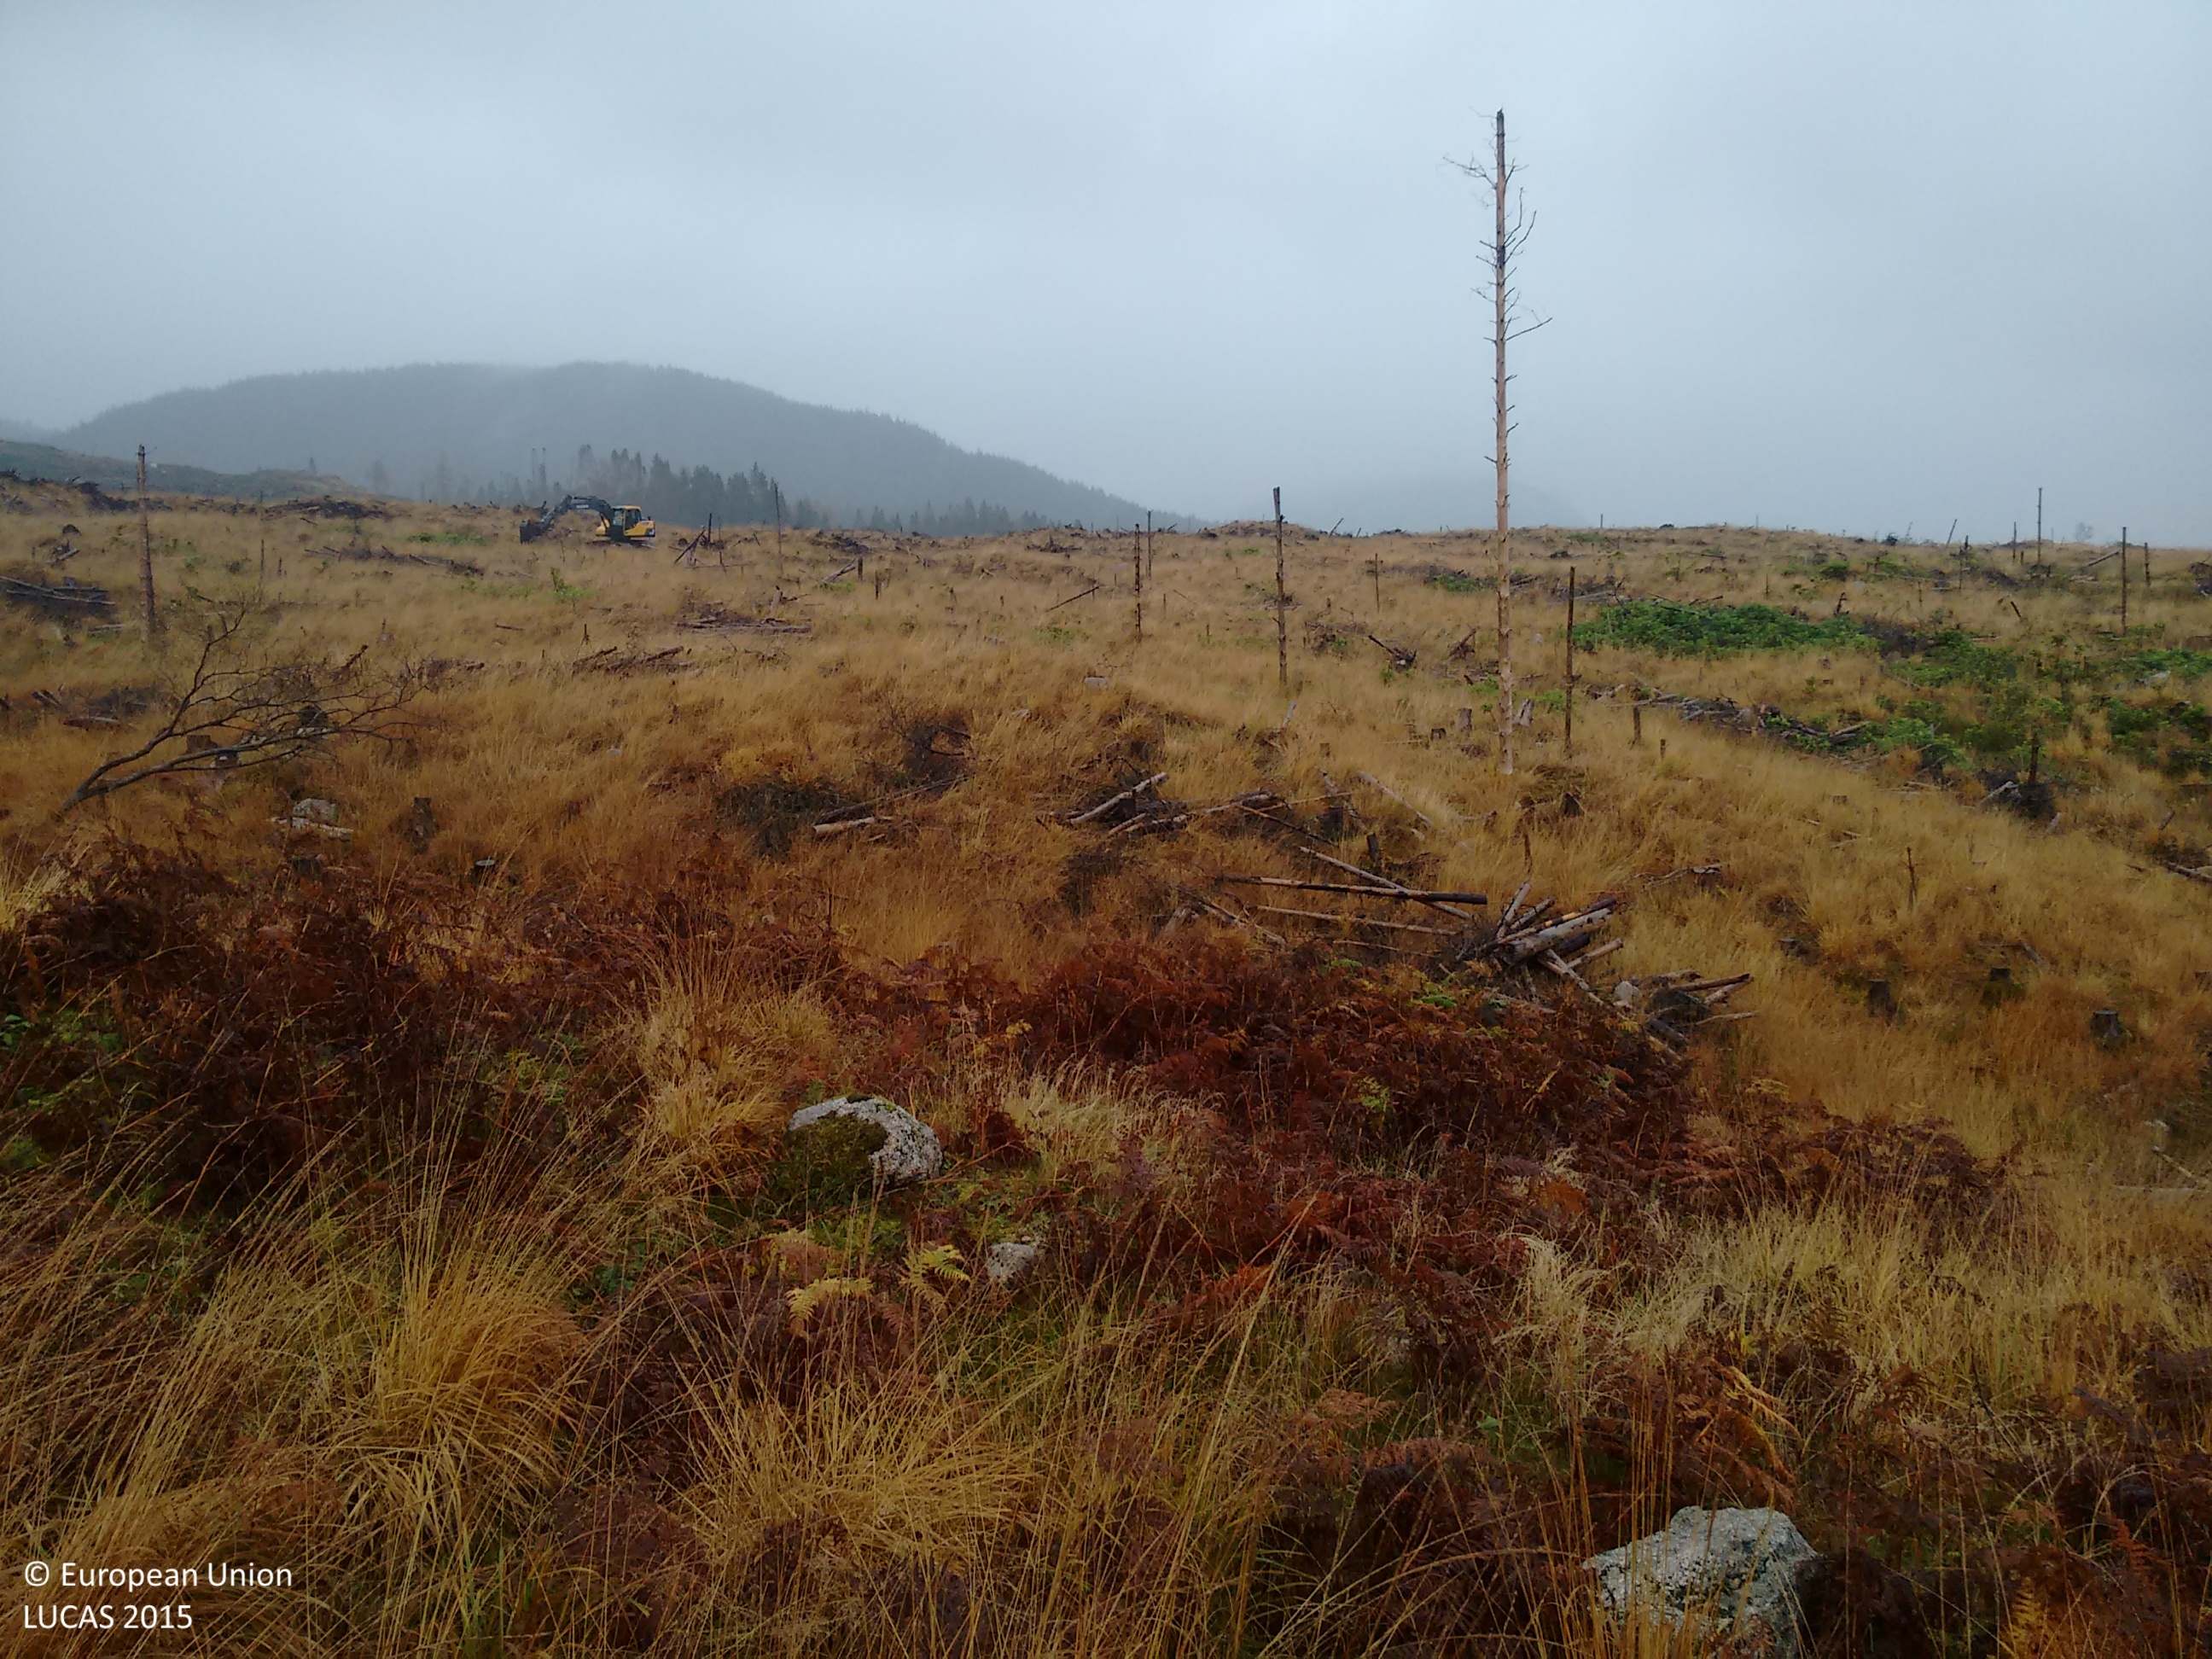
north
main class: Grassland
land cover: Grassland with sparse tree/shrub cover
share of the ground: > 75 %
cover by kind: herbaceous plants 90 %, coniferous forest trees 5 %, shrubs 5 %
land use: Forestry
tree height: < 5 m
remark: Clear cut
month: November
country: GB
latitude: 56.5777
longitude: -5.0357
